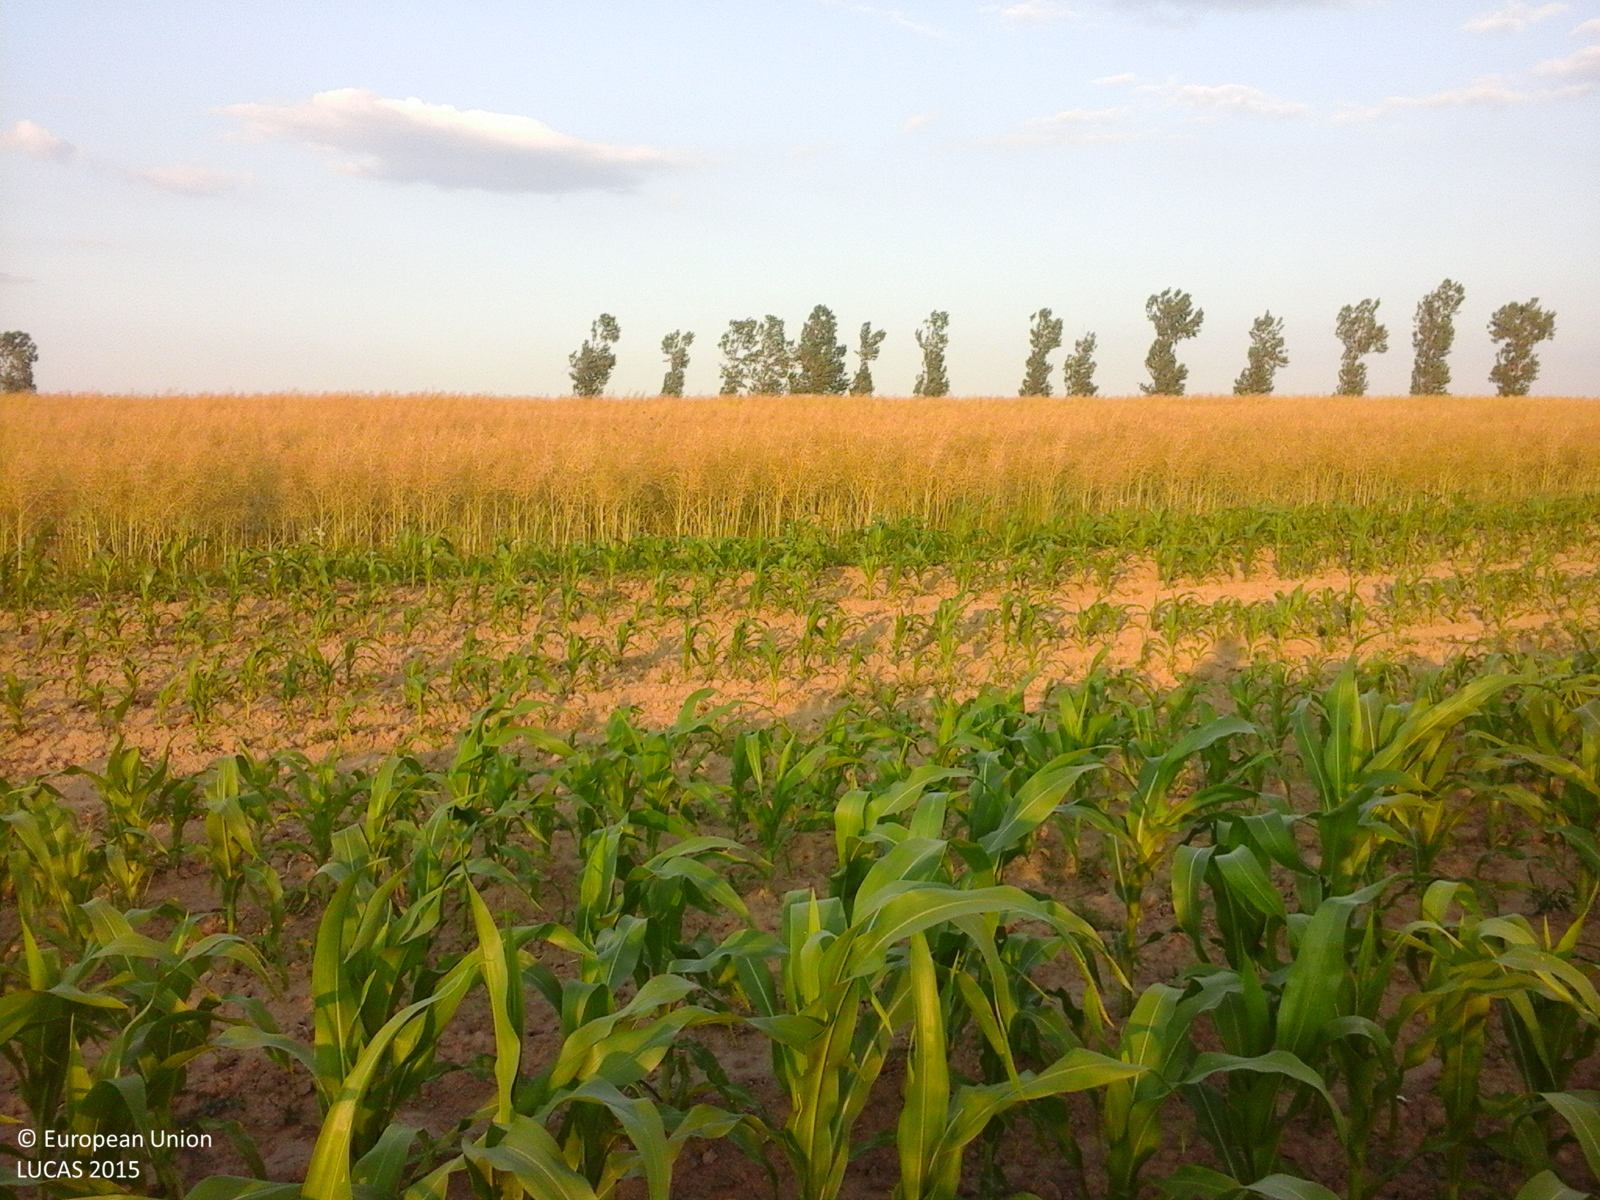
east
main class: Cropland
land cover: Rape and turnip rape
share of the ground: > 75 %
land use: Agriculture (excluding fallow land and kitchen gardens)
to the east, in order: Rape and turnip rape; Maize; Rape and turnip rape; Grass margins; Oats; Common wheat; Maize; Rape and turnip rape
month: June
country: RO
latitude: 46.8095
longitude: 27.0439
